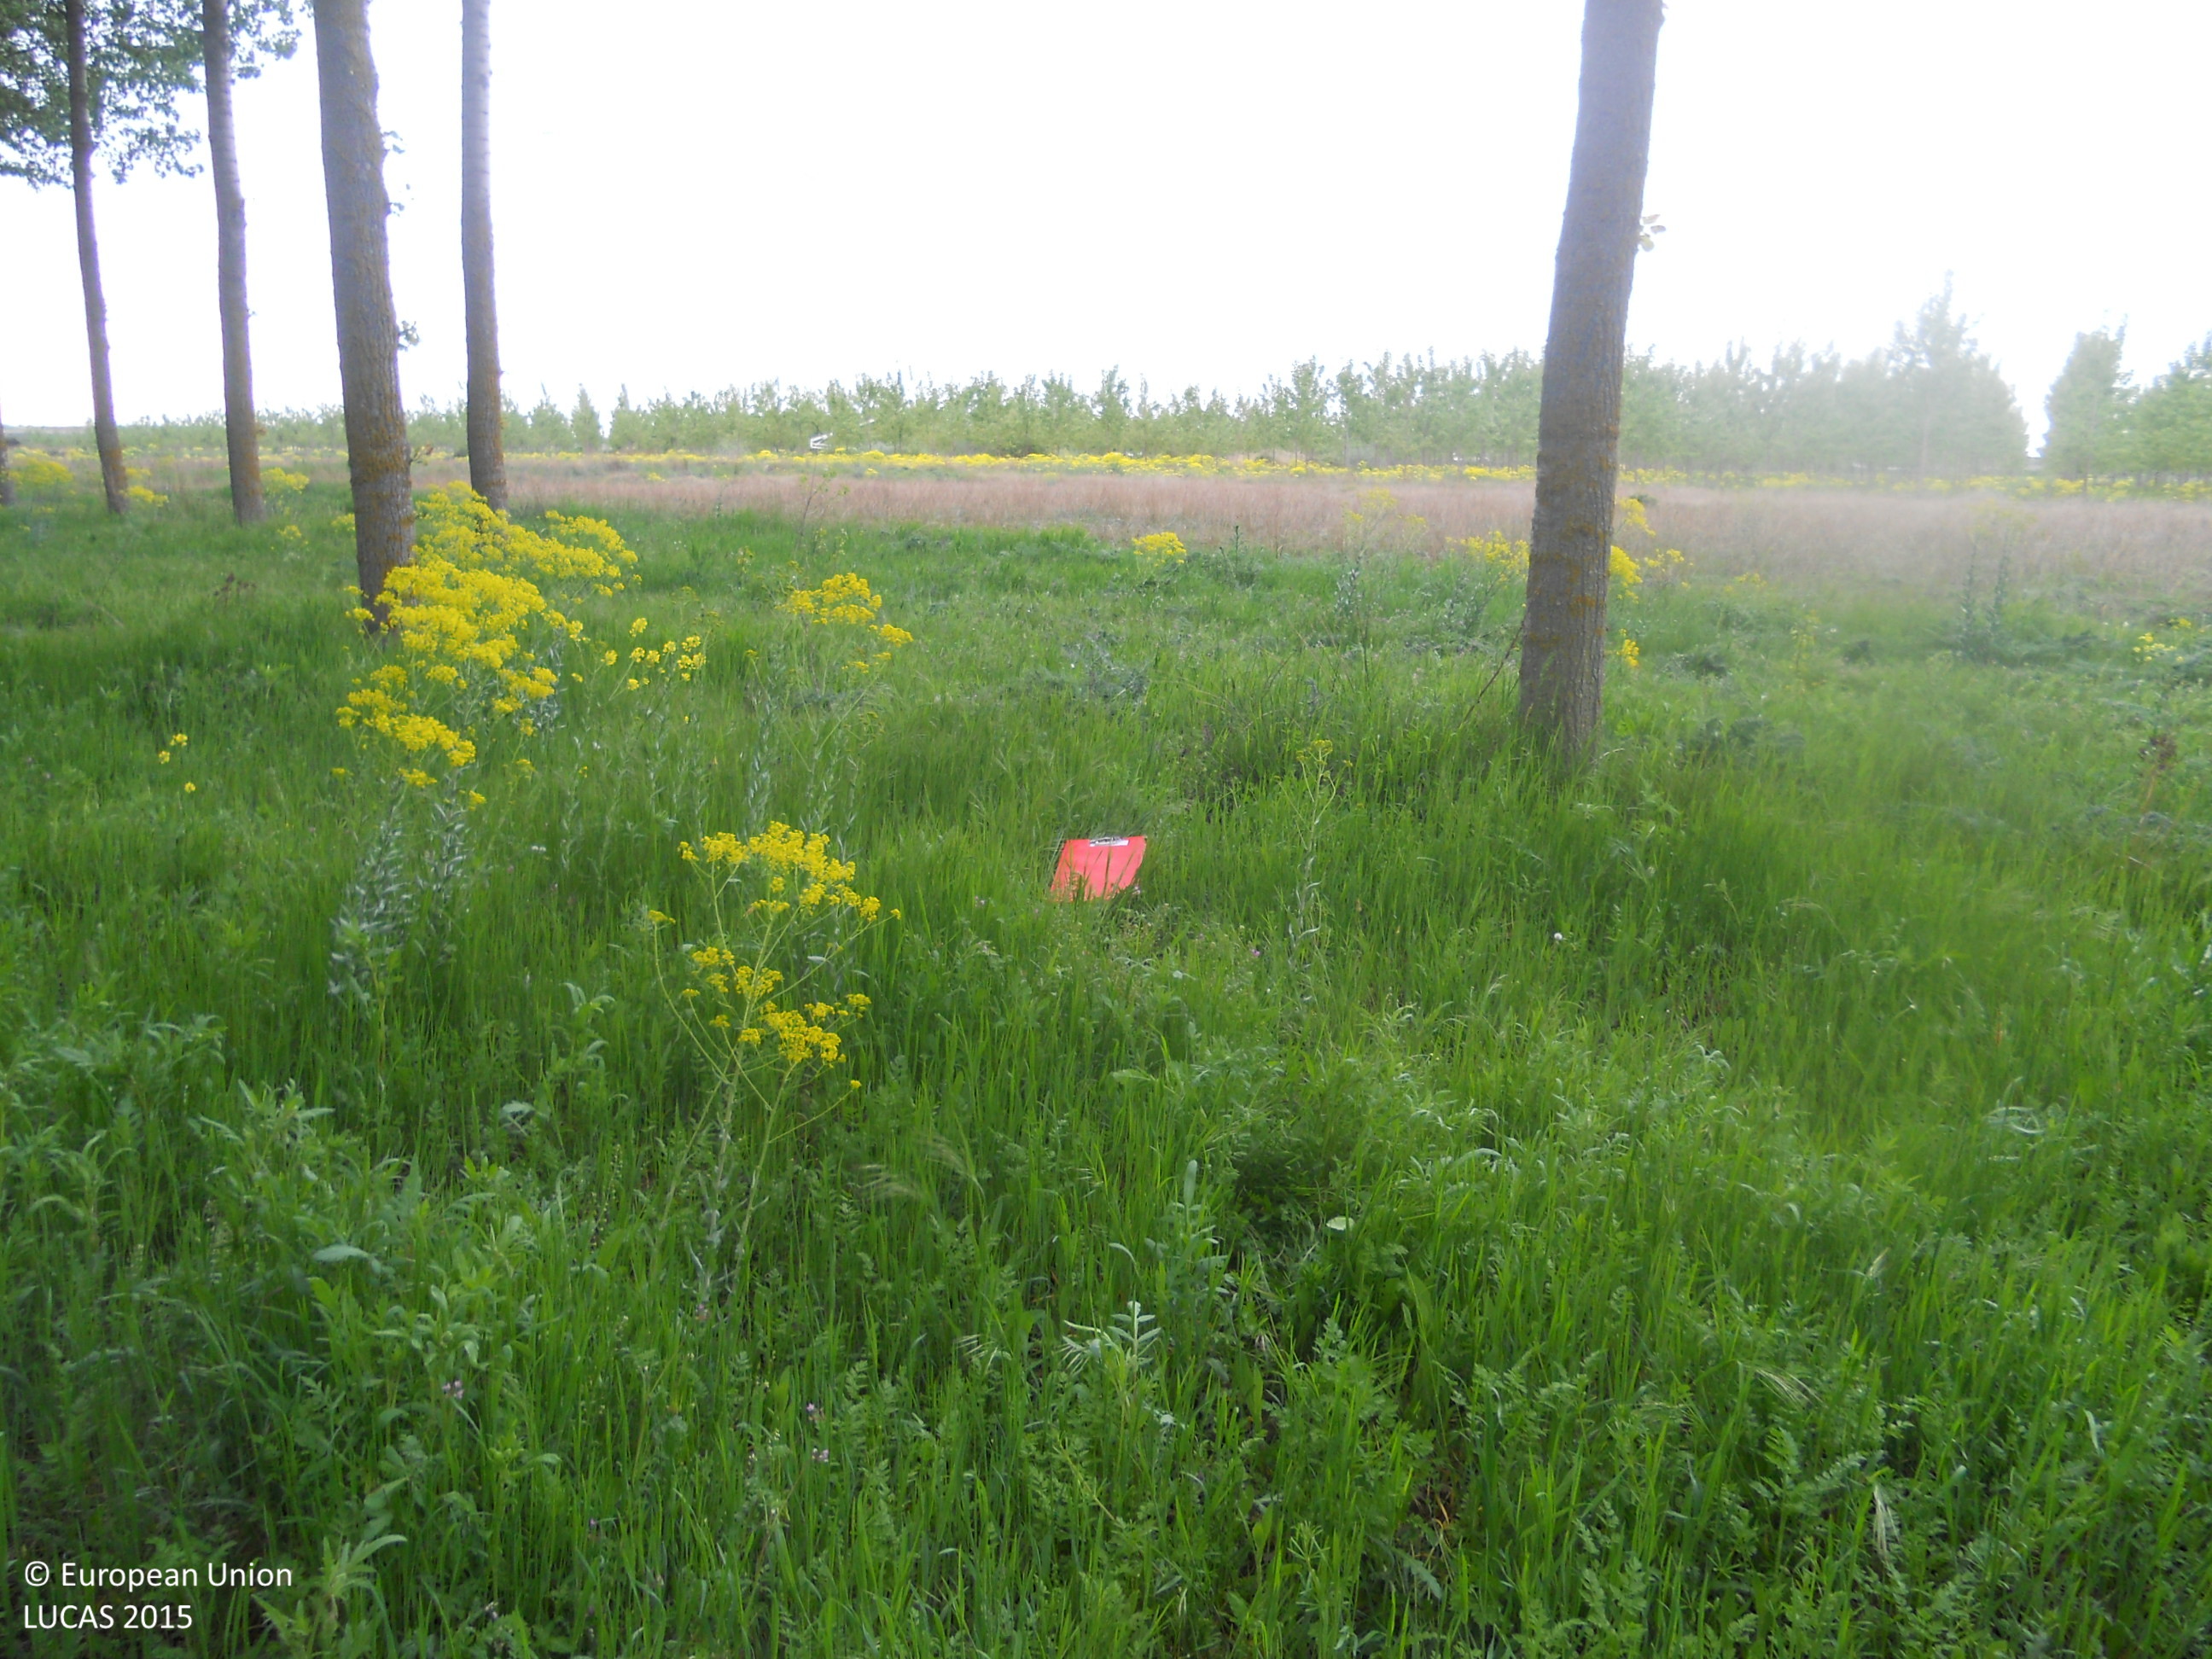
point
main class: Woodland
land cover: Broadleaved woodland
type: floodplain forest
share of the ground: > 75 %
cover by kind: broadleaved forest trees 100 %
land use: Forestry
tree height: > 5 m
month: May
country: ES
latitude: 42.4624
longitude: -5.3782
